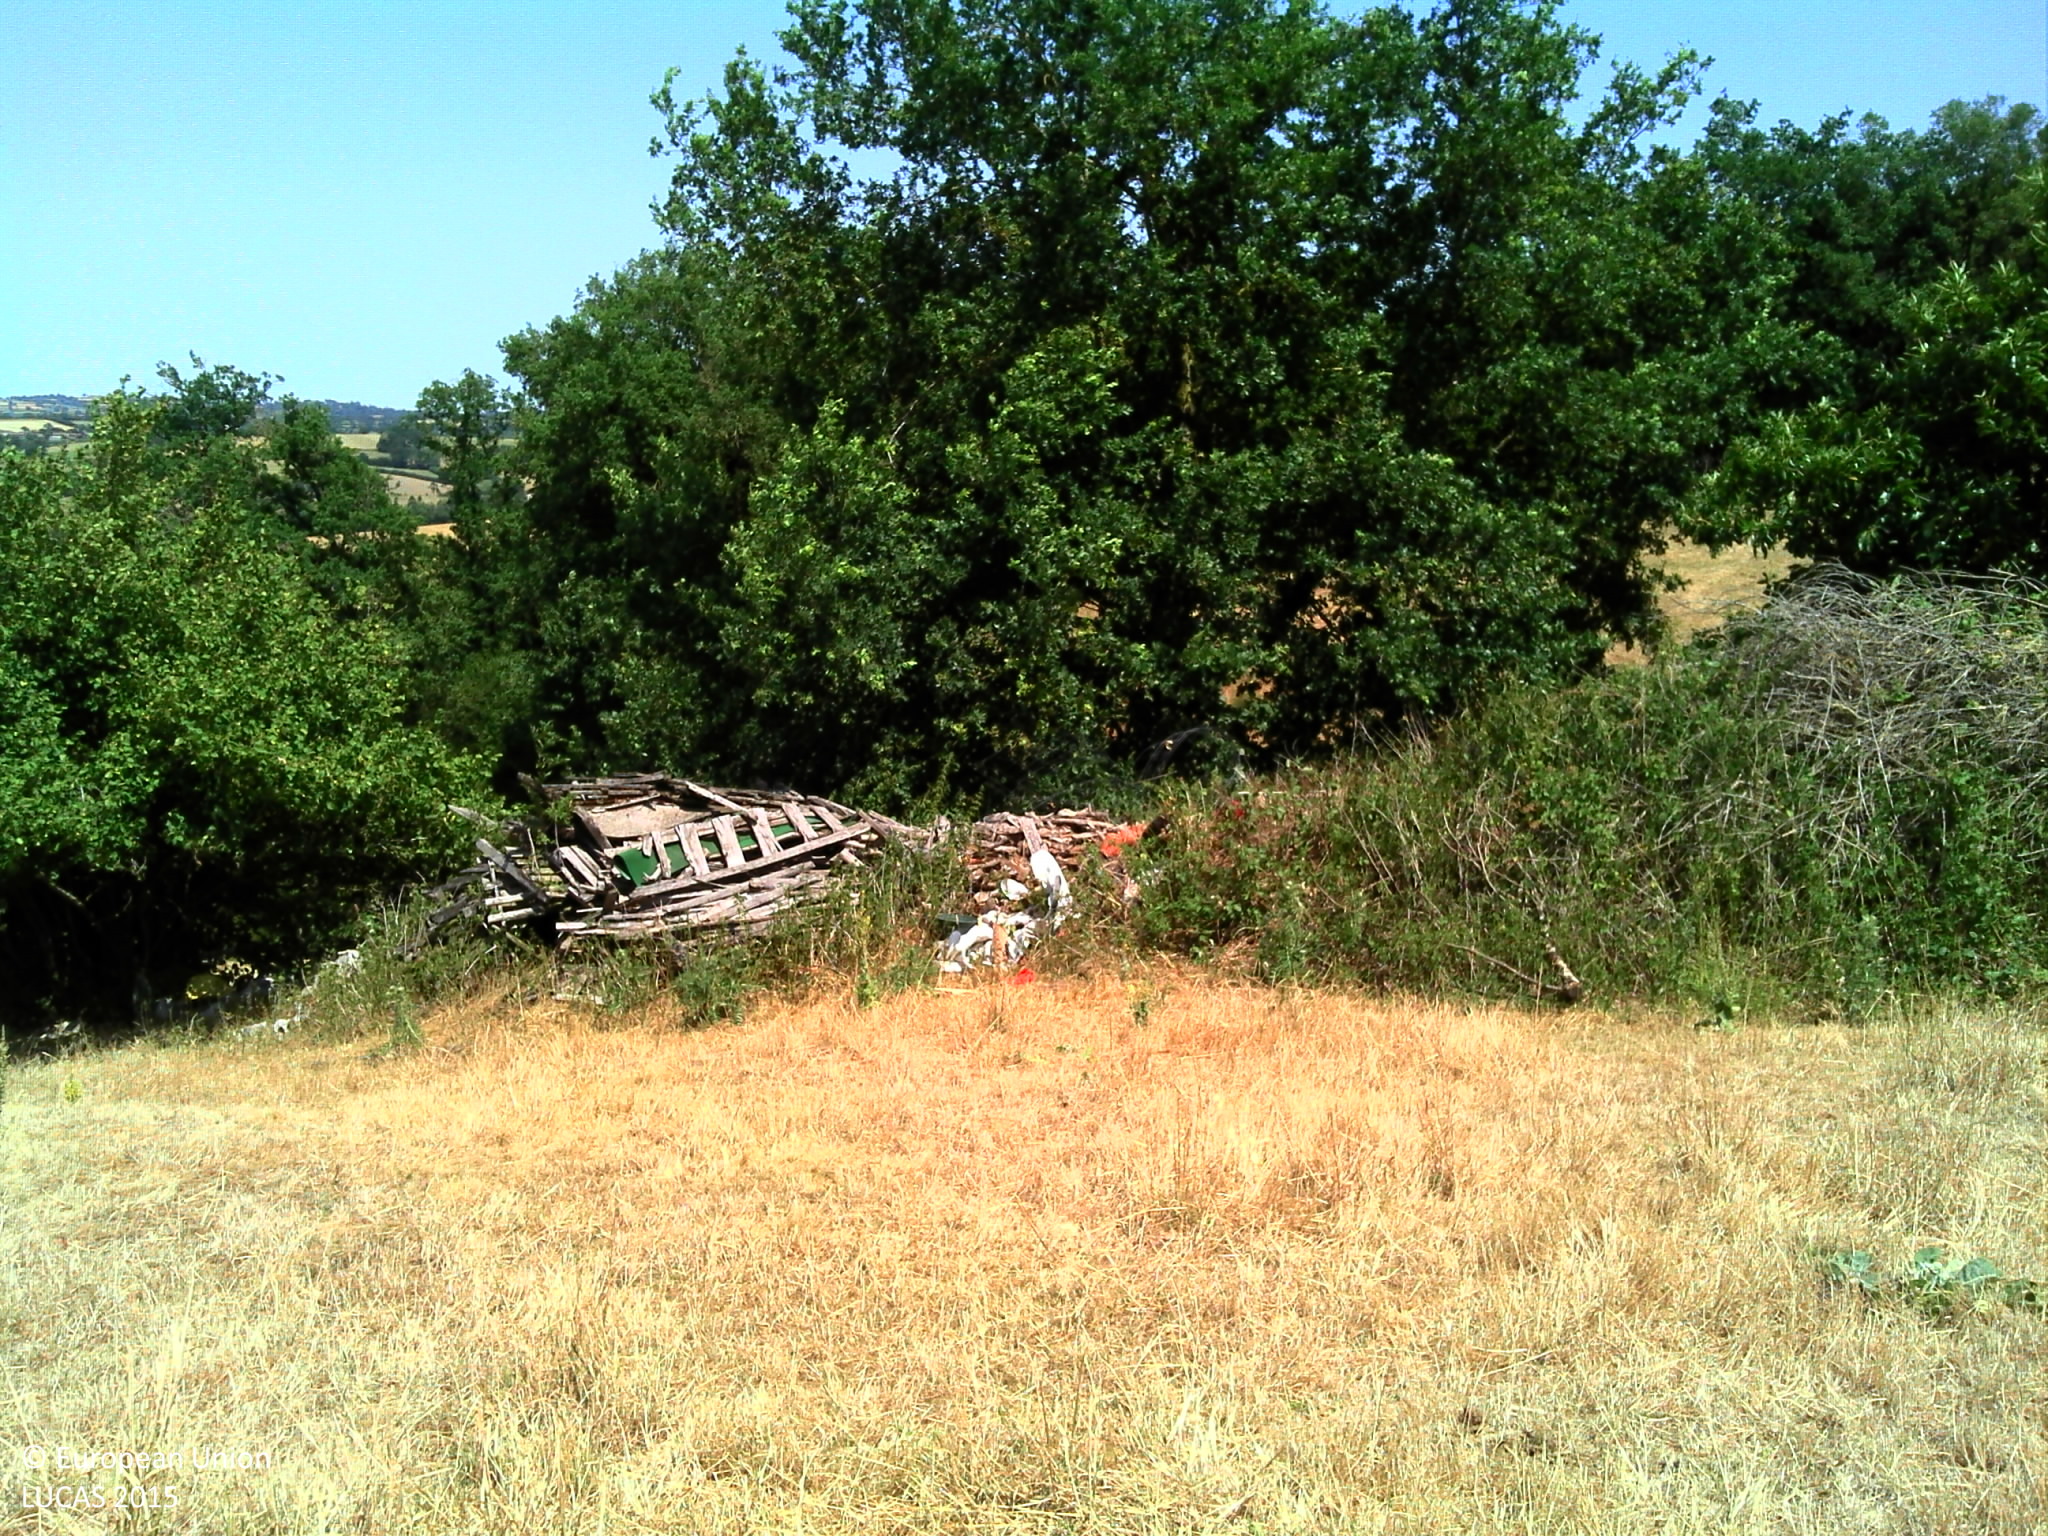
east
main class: Grassland
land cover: Grassland without tree/shrub cover
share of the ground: > 75 %
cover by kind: herbaceous plants 100 %
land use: Agriculture (excluding fallow land and kitchen gardens)
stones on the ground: 10 - 25 %
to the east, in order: Grassland without tree/shrub cover; Artificial constructions in urban areas; Dry stone walls; Broadleaved woodland; Grassland without tree/shrub cover; Dry stone walls; Fences; Broadleaved woodland; Fences; Grassland without tree/shrub cover; Fences; Broadleaved woodland; Fences; Grassland without tree/shrub cover
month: July
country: FR
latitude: 44.1757
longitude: 2.5870
